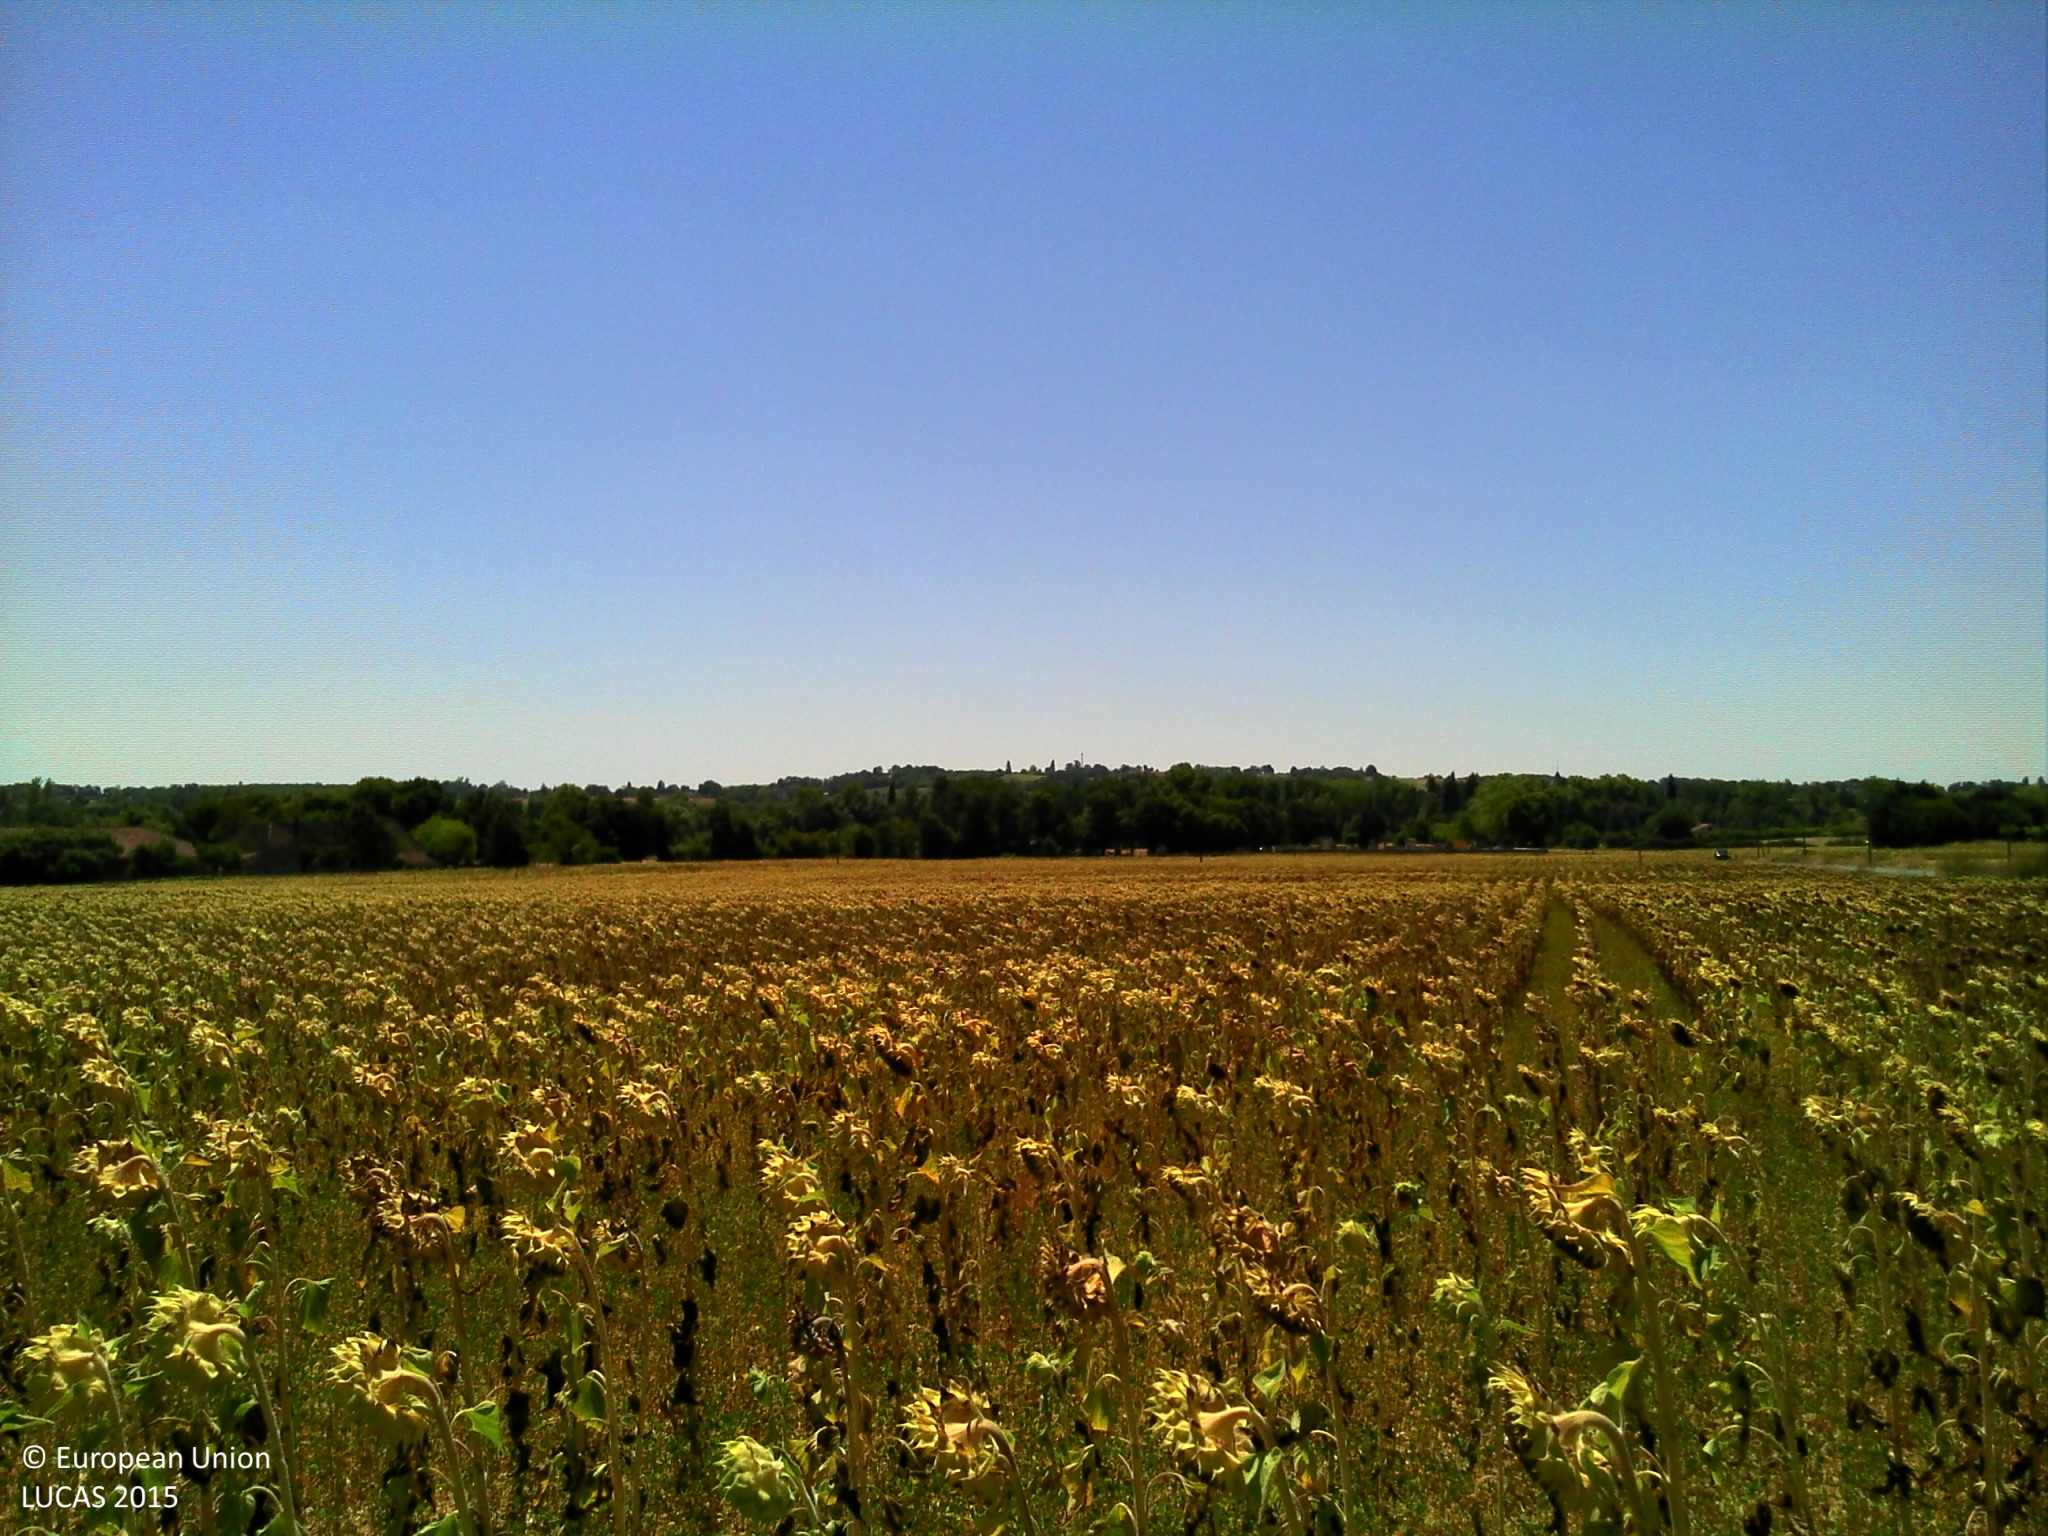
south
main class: Cropland
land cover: Sunflower
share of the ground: 25 - 50 %
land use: Agriculture (excluding fallow land and kitchen gardens)
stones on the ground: > 50 %
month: August
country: FR
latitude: 44.7403
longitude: 0.6083
